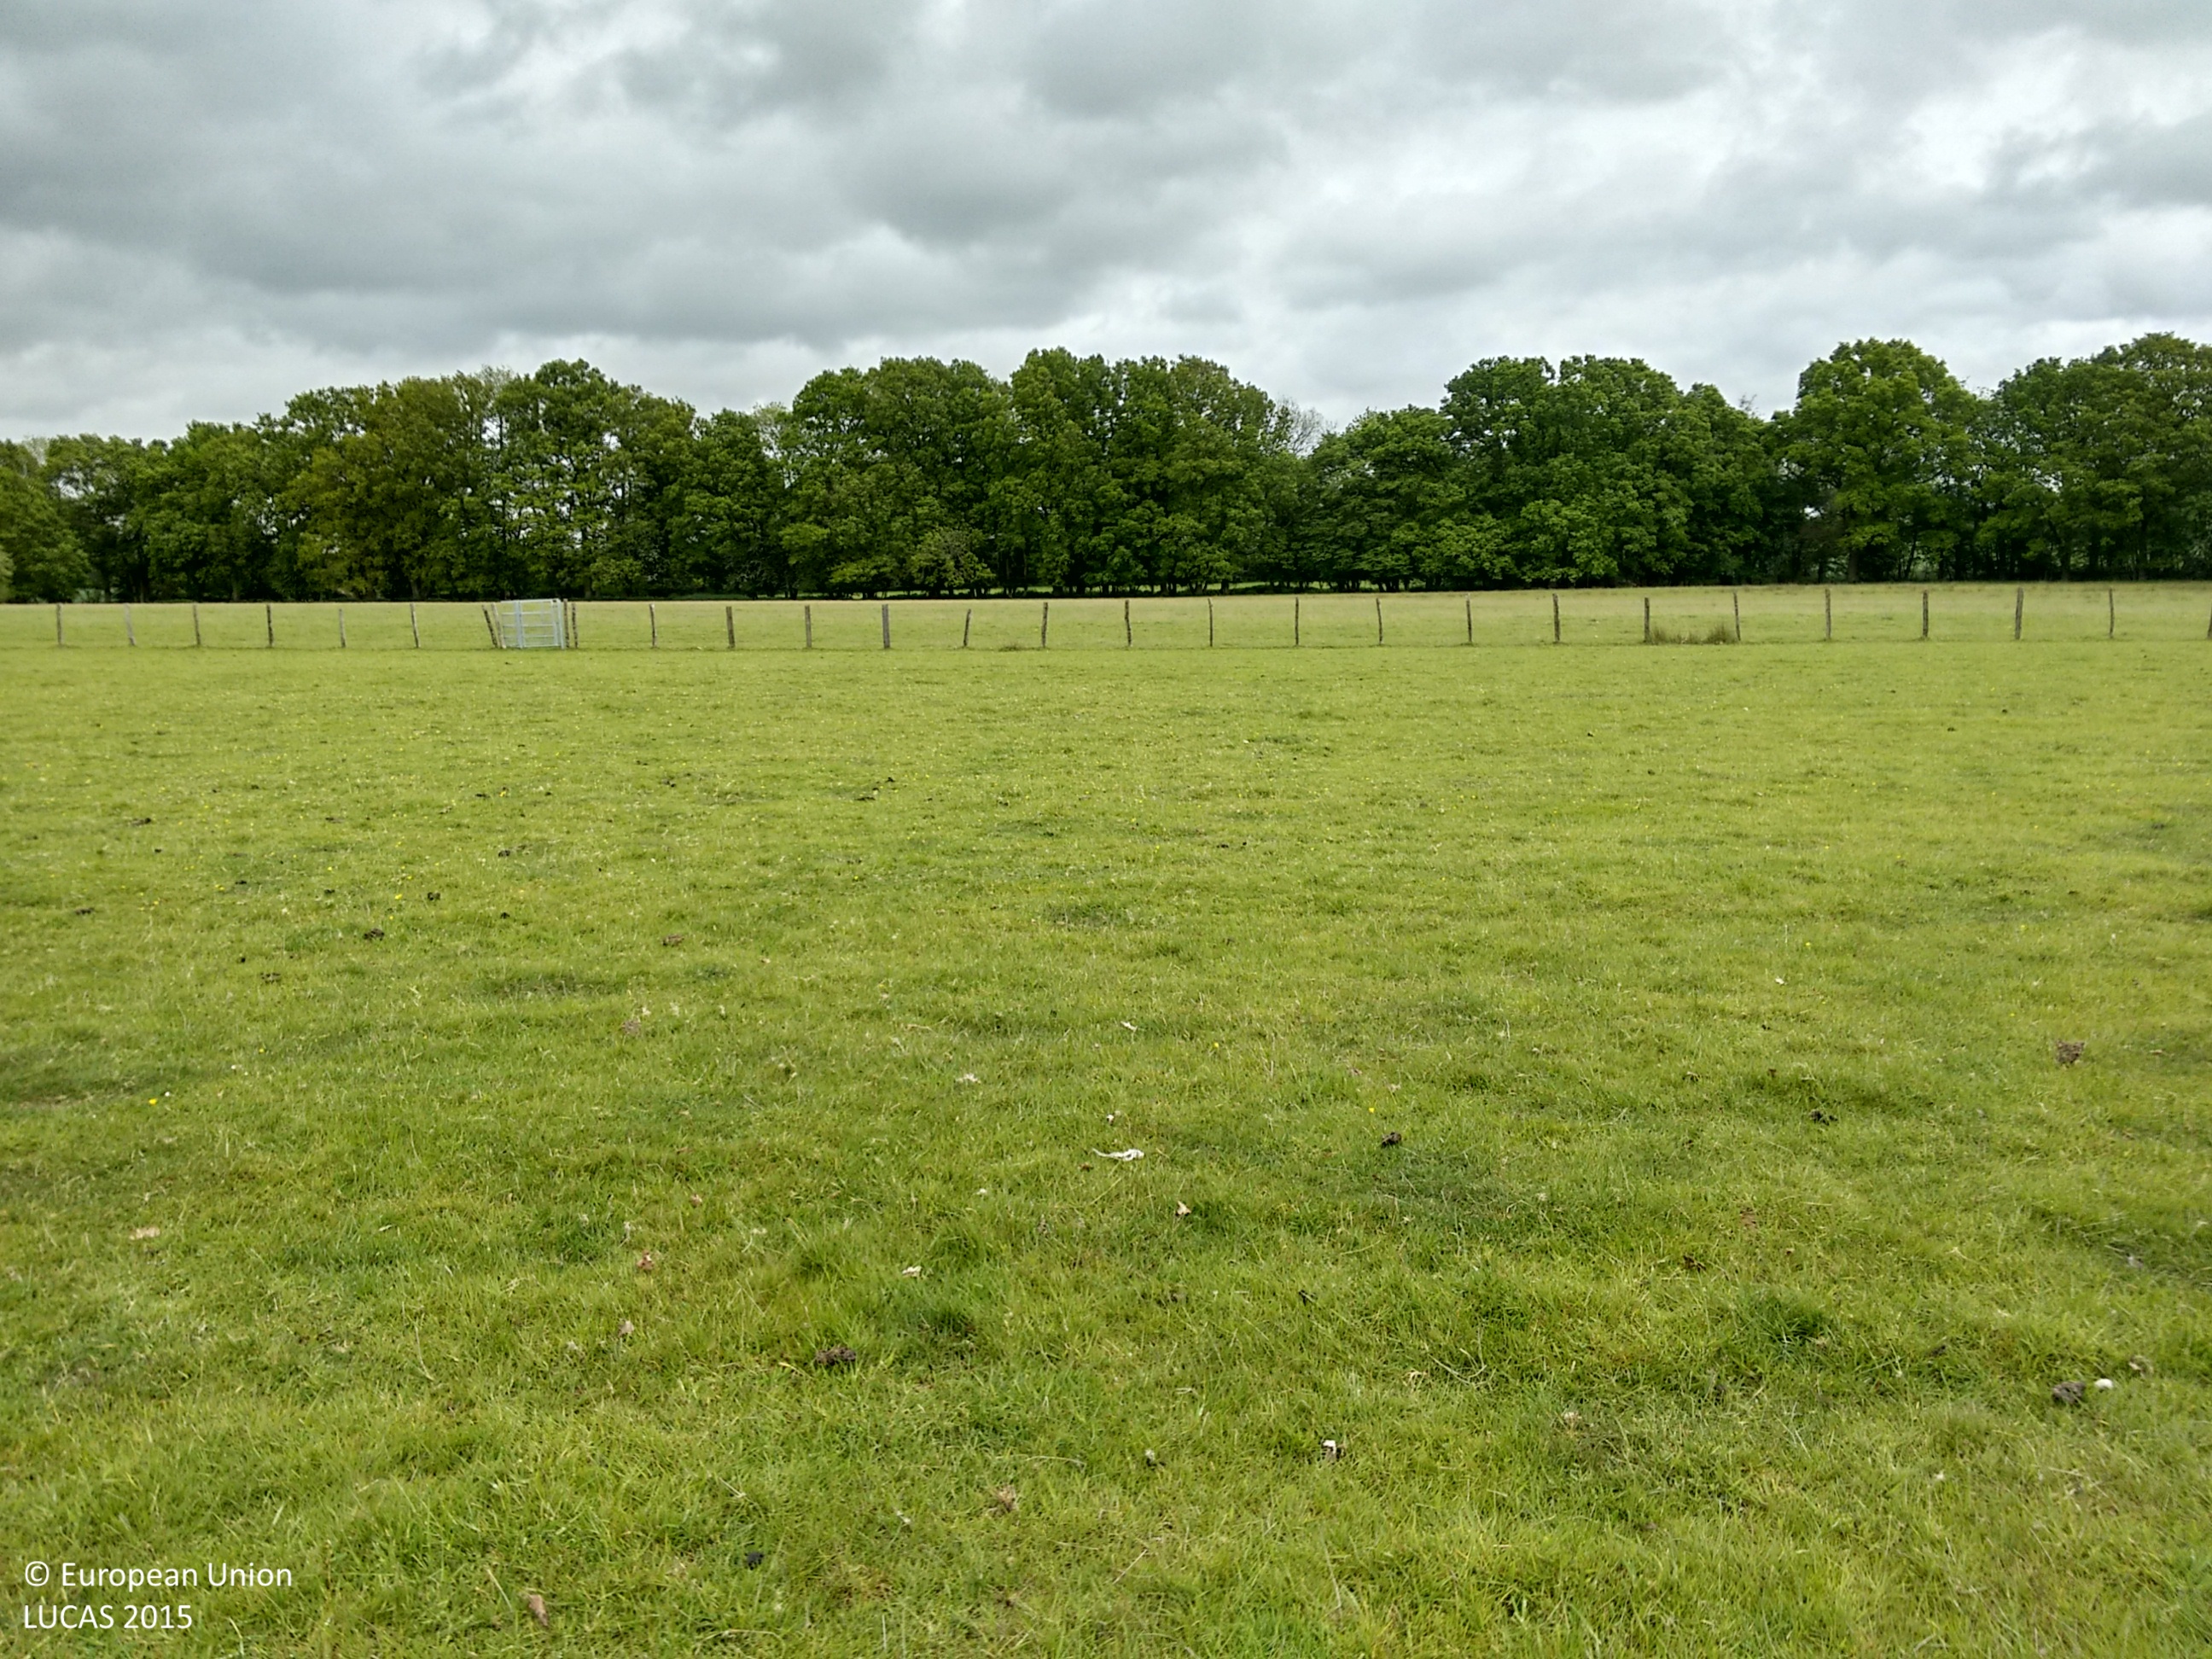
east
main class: Grassland
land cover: Grassland without tree/shrub cover
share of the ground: > 75 %
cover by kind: herbaceous plants 100 %
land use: Agriculture (excluding fallow land and kitchen gardens)
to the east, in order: Grassland without tree/shrub cover; Fences; Broadleaved woodland; Ditches and canals; Broadleaved woodland; Grassland without tree/shrub cover; Broadleaved woodland; Fences; Common wheat
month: May
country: GB
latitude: 51.1938
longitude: 0.6581
